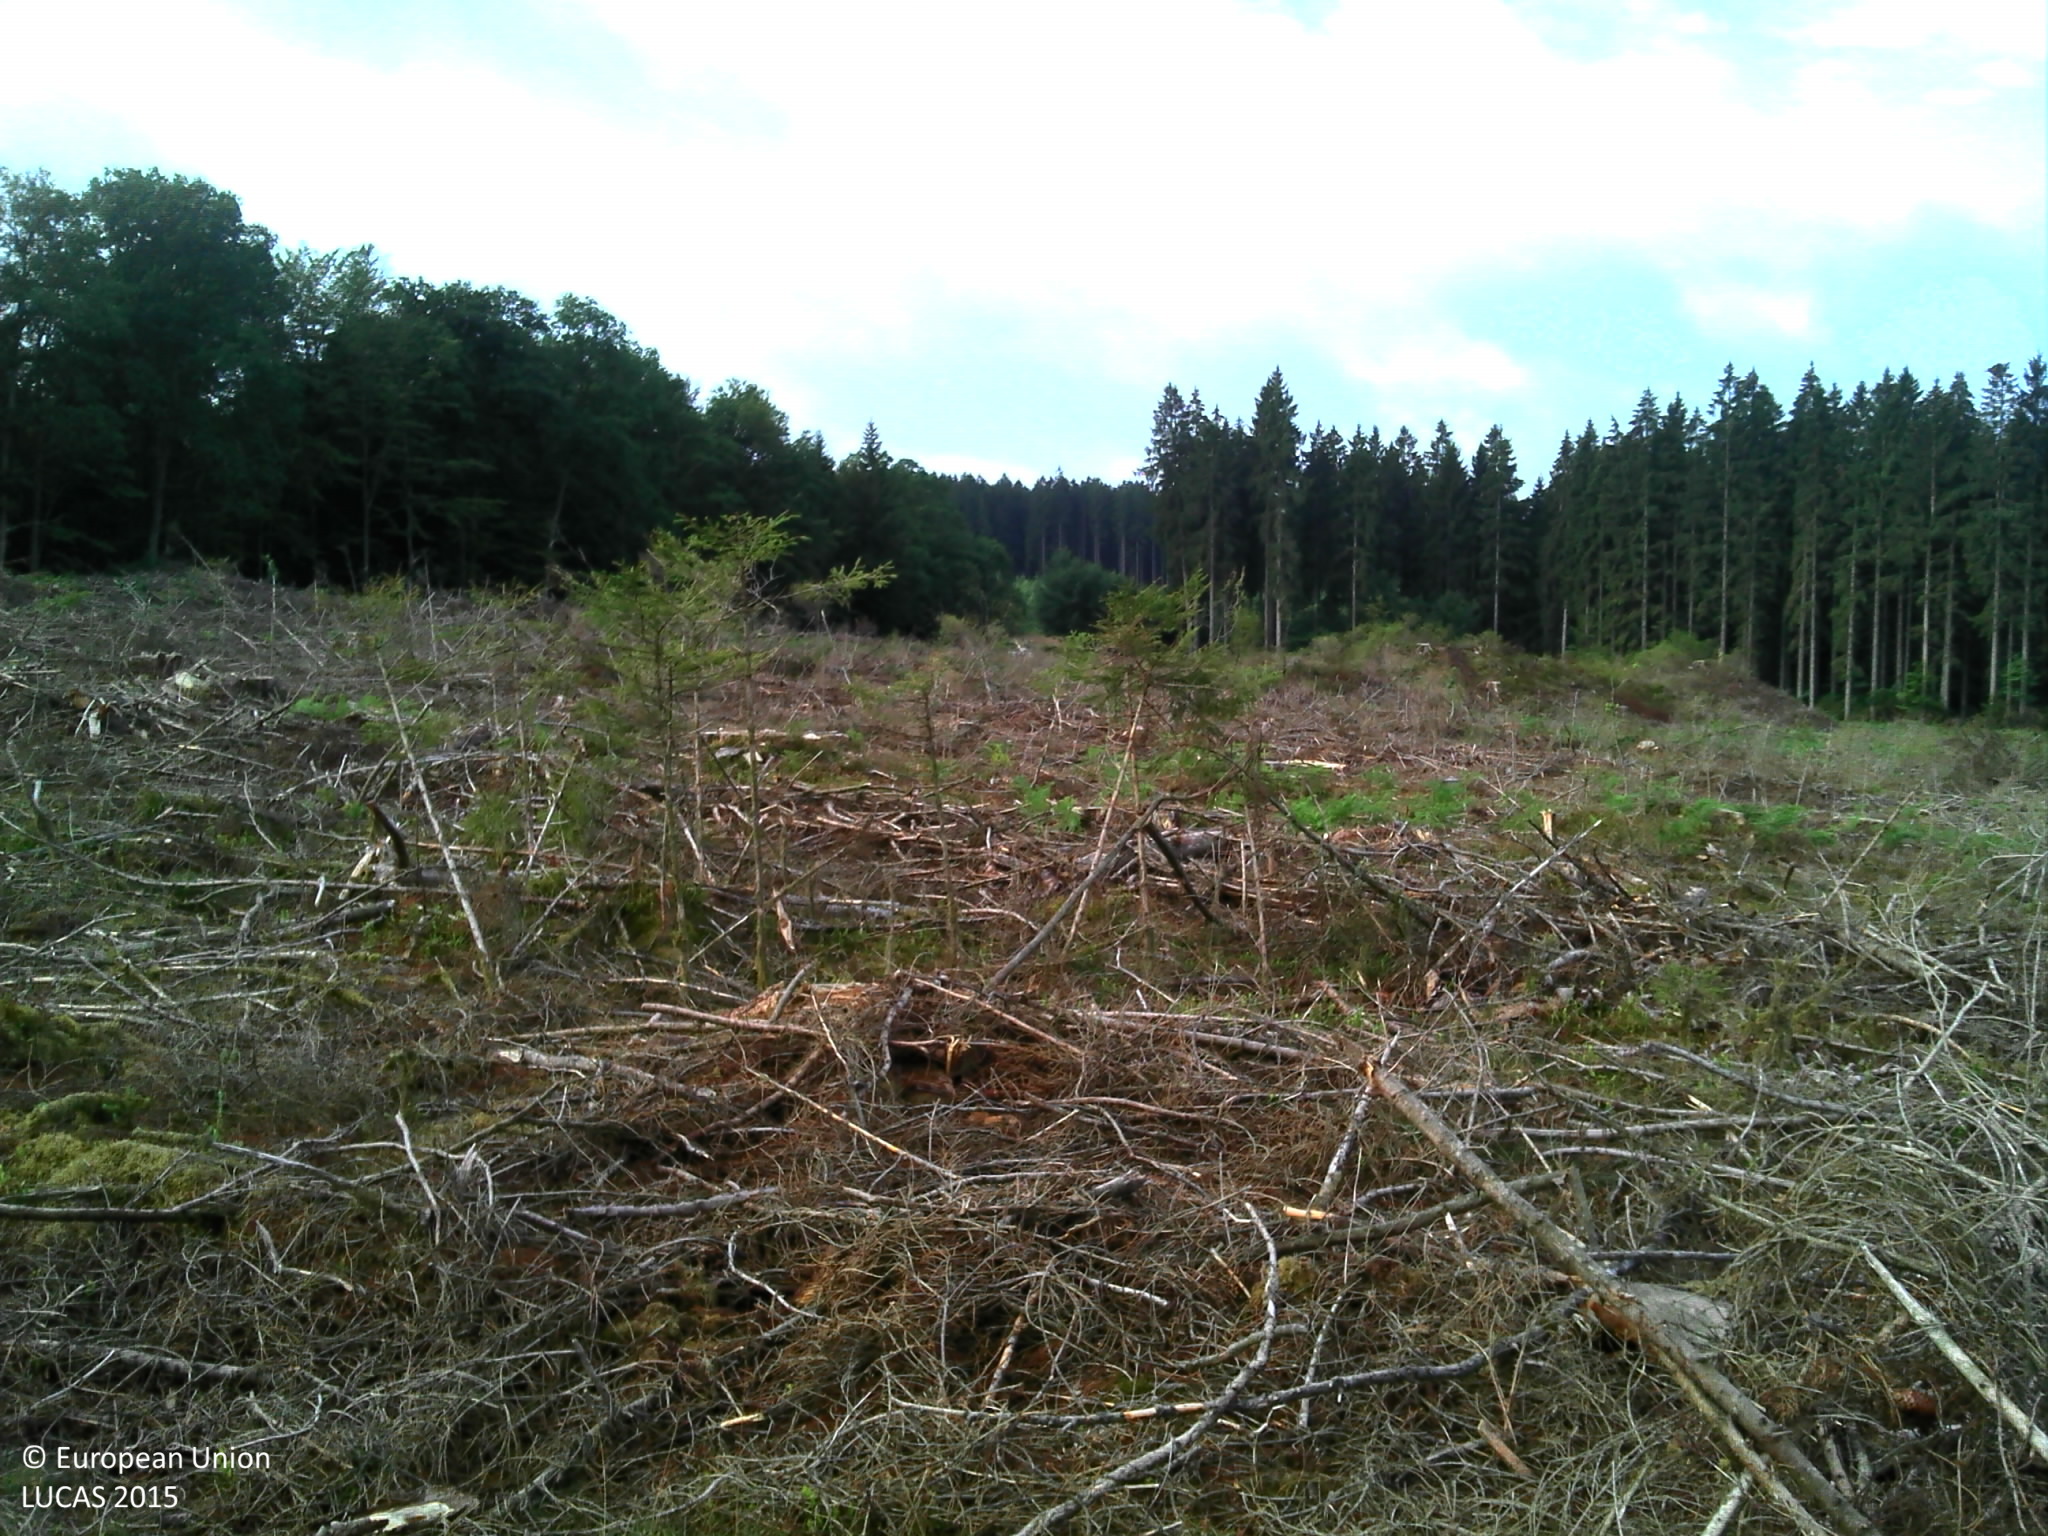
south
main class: Grassland
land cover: Spontaneously vegetated surfaces
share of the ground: 50 - 75 %
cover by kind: herbaceous plants 65 %, unconsolidated bare surface 30 %, shrubs 5 %
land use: Forestry
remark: Clear cut
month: July
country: BE
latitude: 49.7639
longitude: 5.3195
